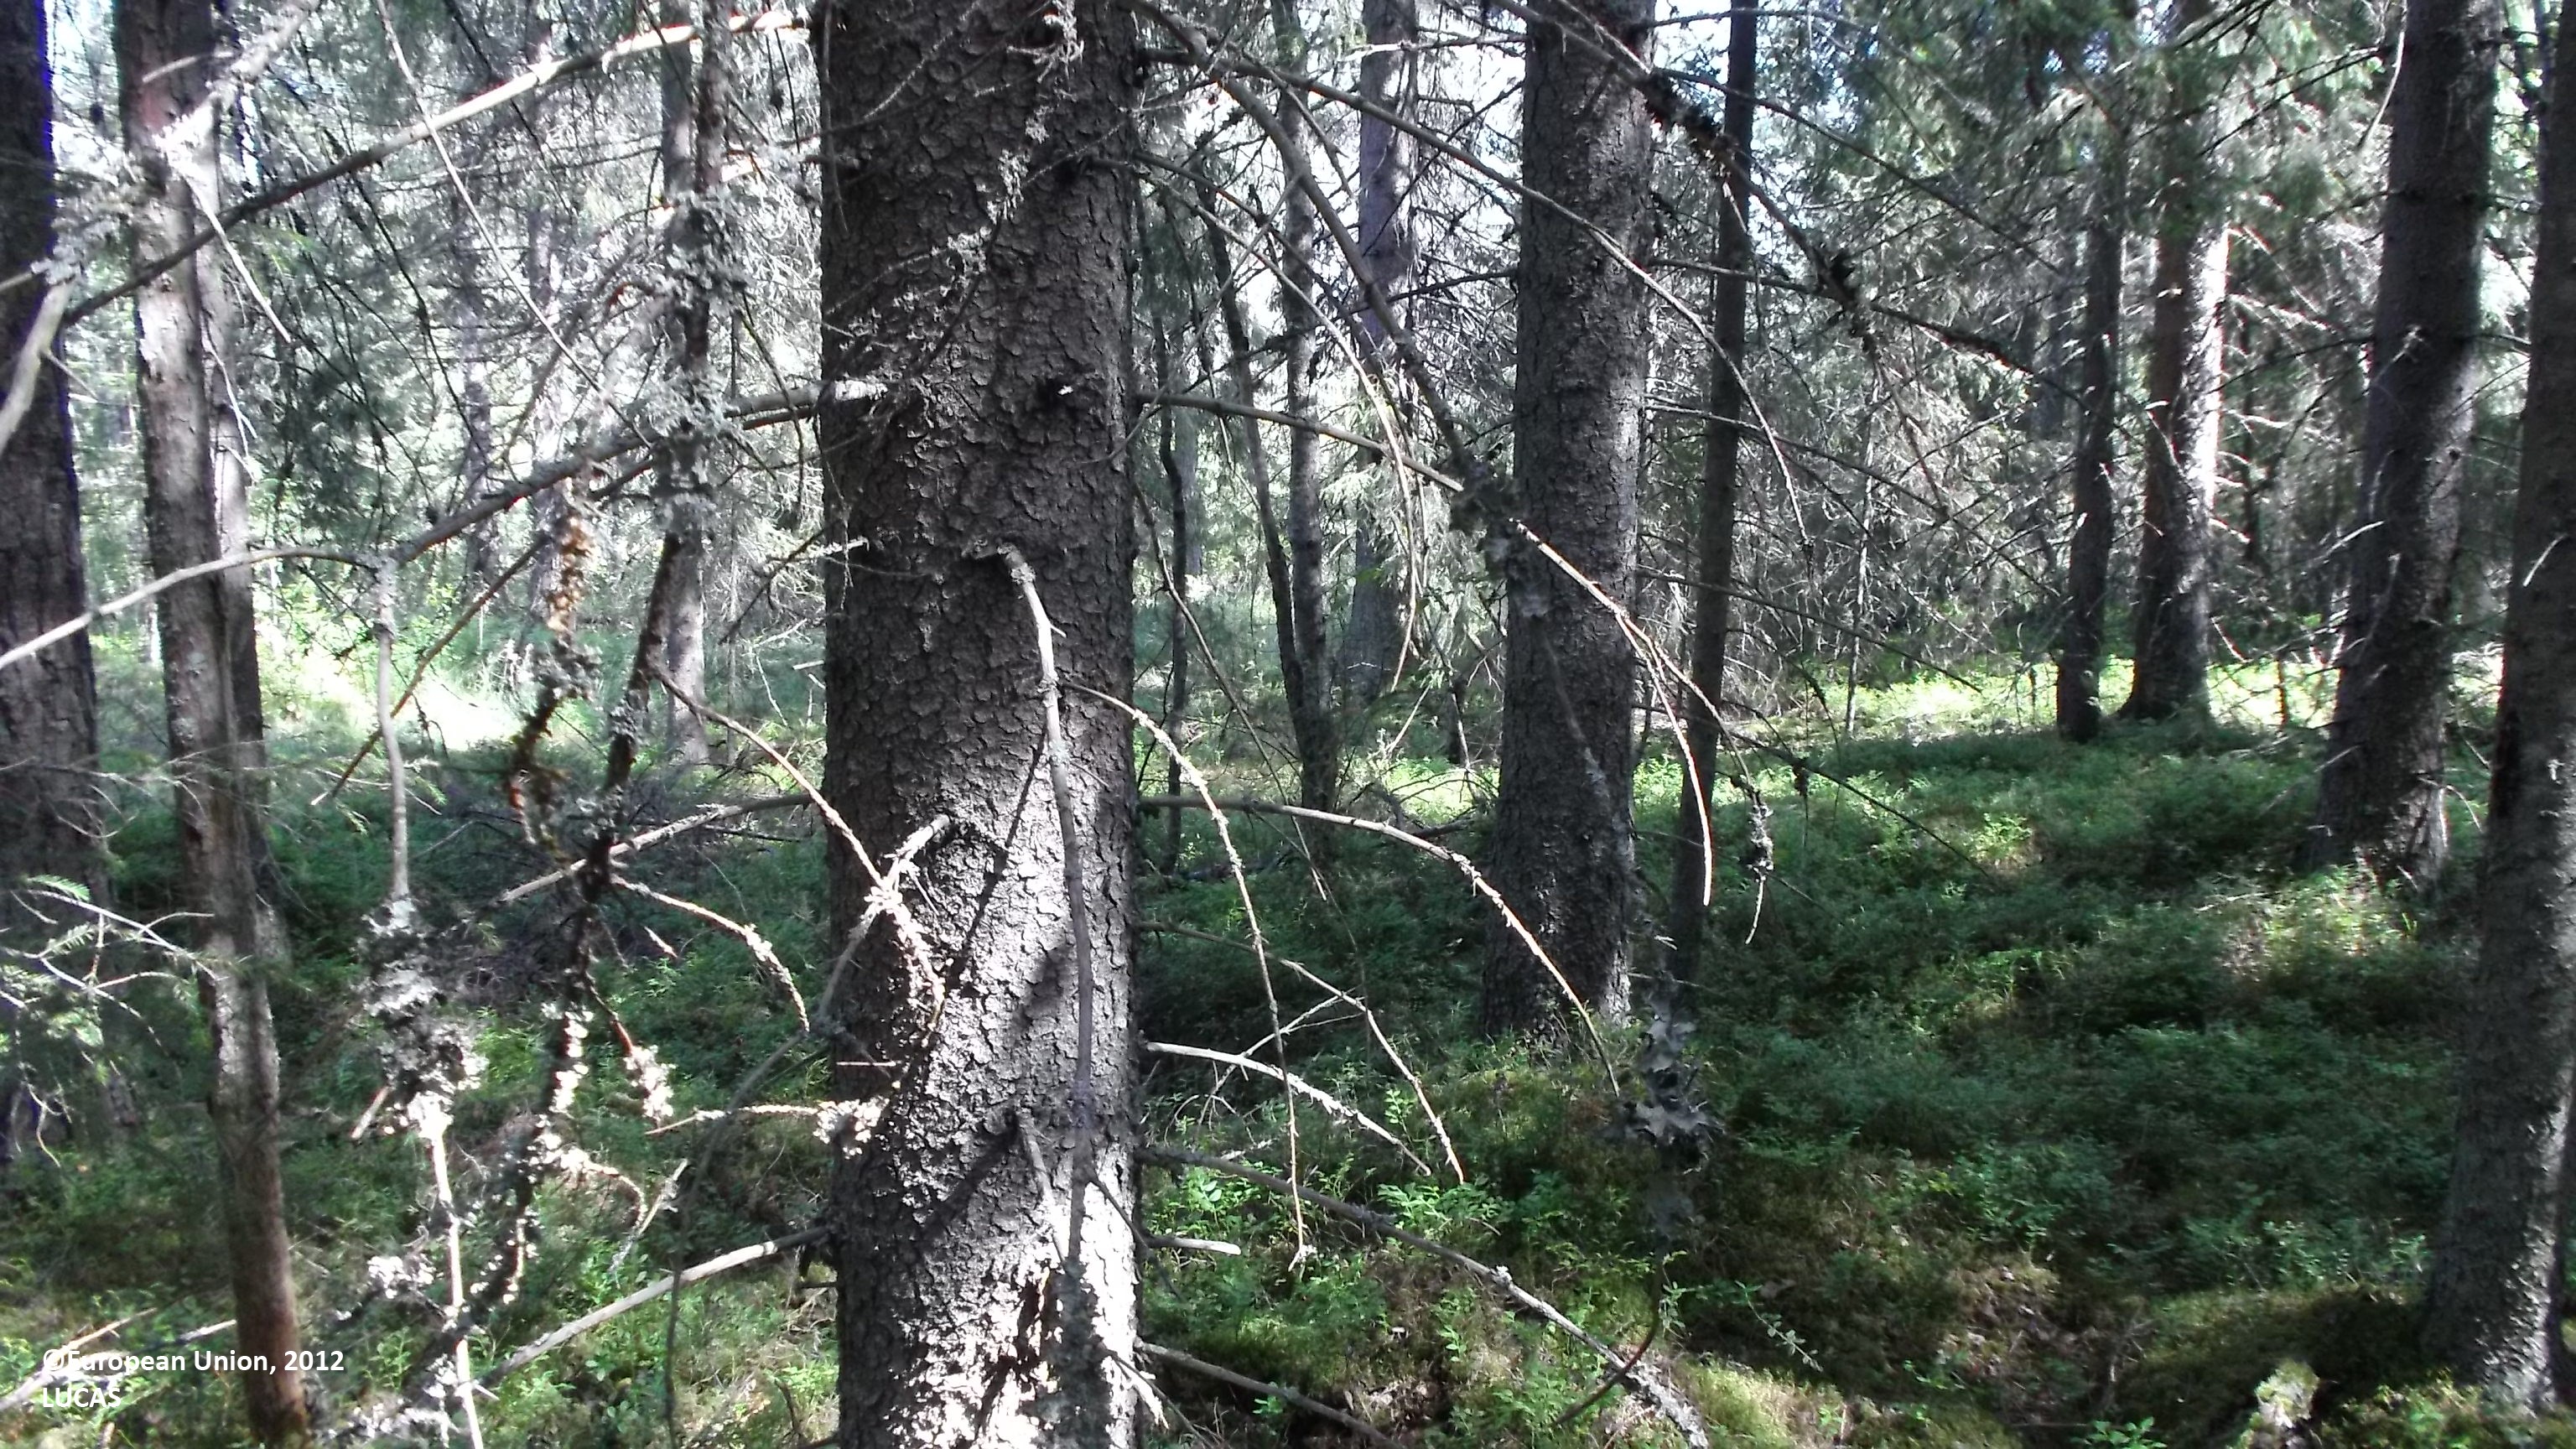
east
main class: Woodland
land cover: Spruce dominated coniferous woodland
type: boreal forest
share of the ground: > 75 %
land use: Forestry
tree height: > 5 m
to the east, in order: Spruce dominated coniferous woodland; Tracks; Other mixed woodland; Ditches and canals; Spontaneously vegetated surfaces; Paved roads, cycling and walking lanes; Grassland without tree/shrub cover; Other mixed woodland; Spontaneously vegetated surfaces; Other mixed woodland; Spontaneously vegetated surfaces; Ditches and canals; Spontaneously vegetated surfaces; Ditches and canals; Spontaneously vegetated surfaces; Grassland with sparse tree/shrub cover; Ditches and canals; Grassland with sparse tree/shrub cover; Ditches and canals; Grassland with sparse tree/shrub cover
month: July
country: FI
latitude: 63.6642
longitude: 23.9891
